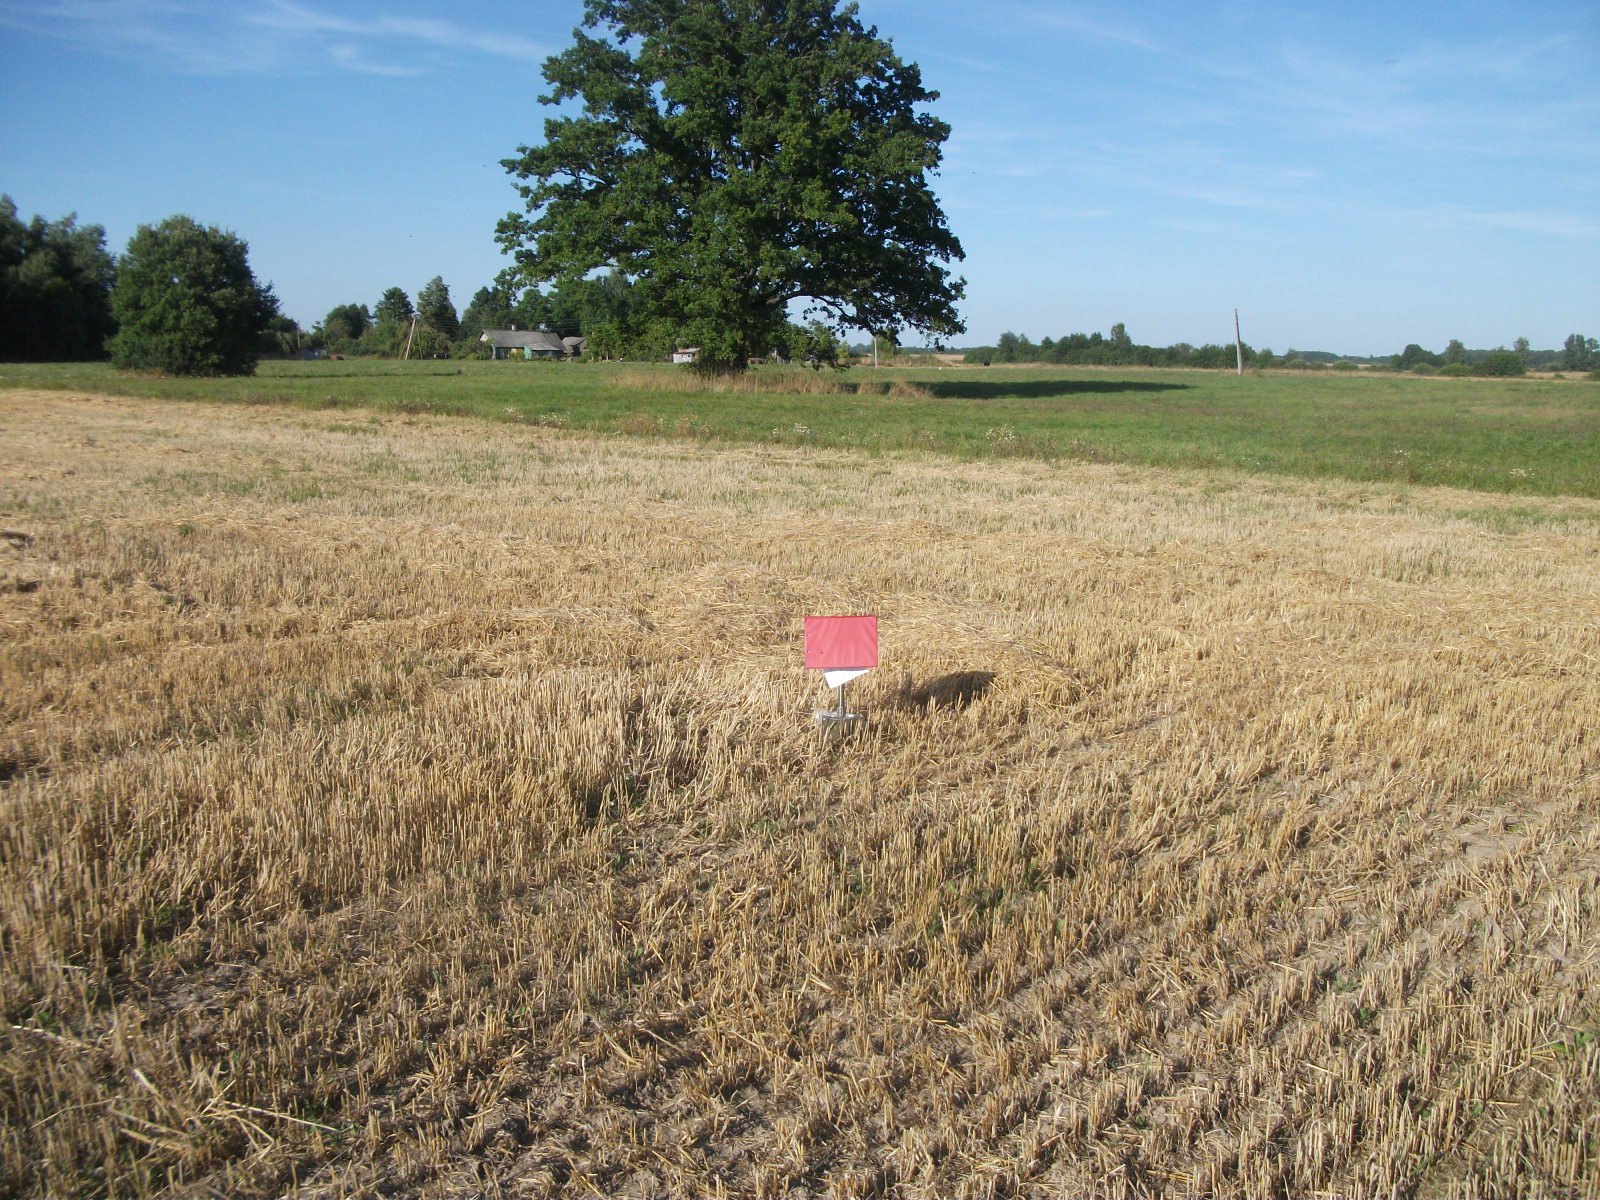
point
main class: Cropland
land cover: Barley
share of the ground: < 10 %
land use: Agriculture (excluding fallow land and kitchen gardens)
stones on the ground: < 10 %
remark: Harvested field
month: August
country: LV
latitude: 56.5210
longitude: 26.2485
